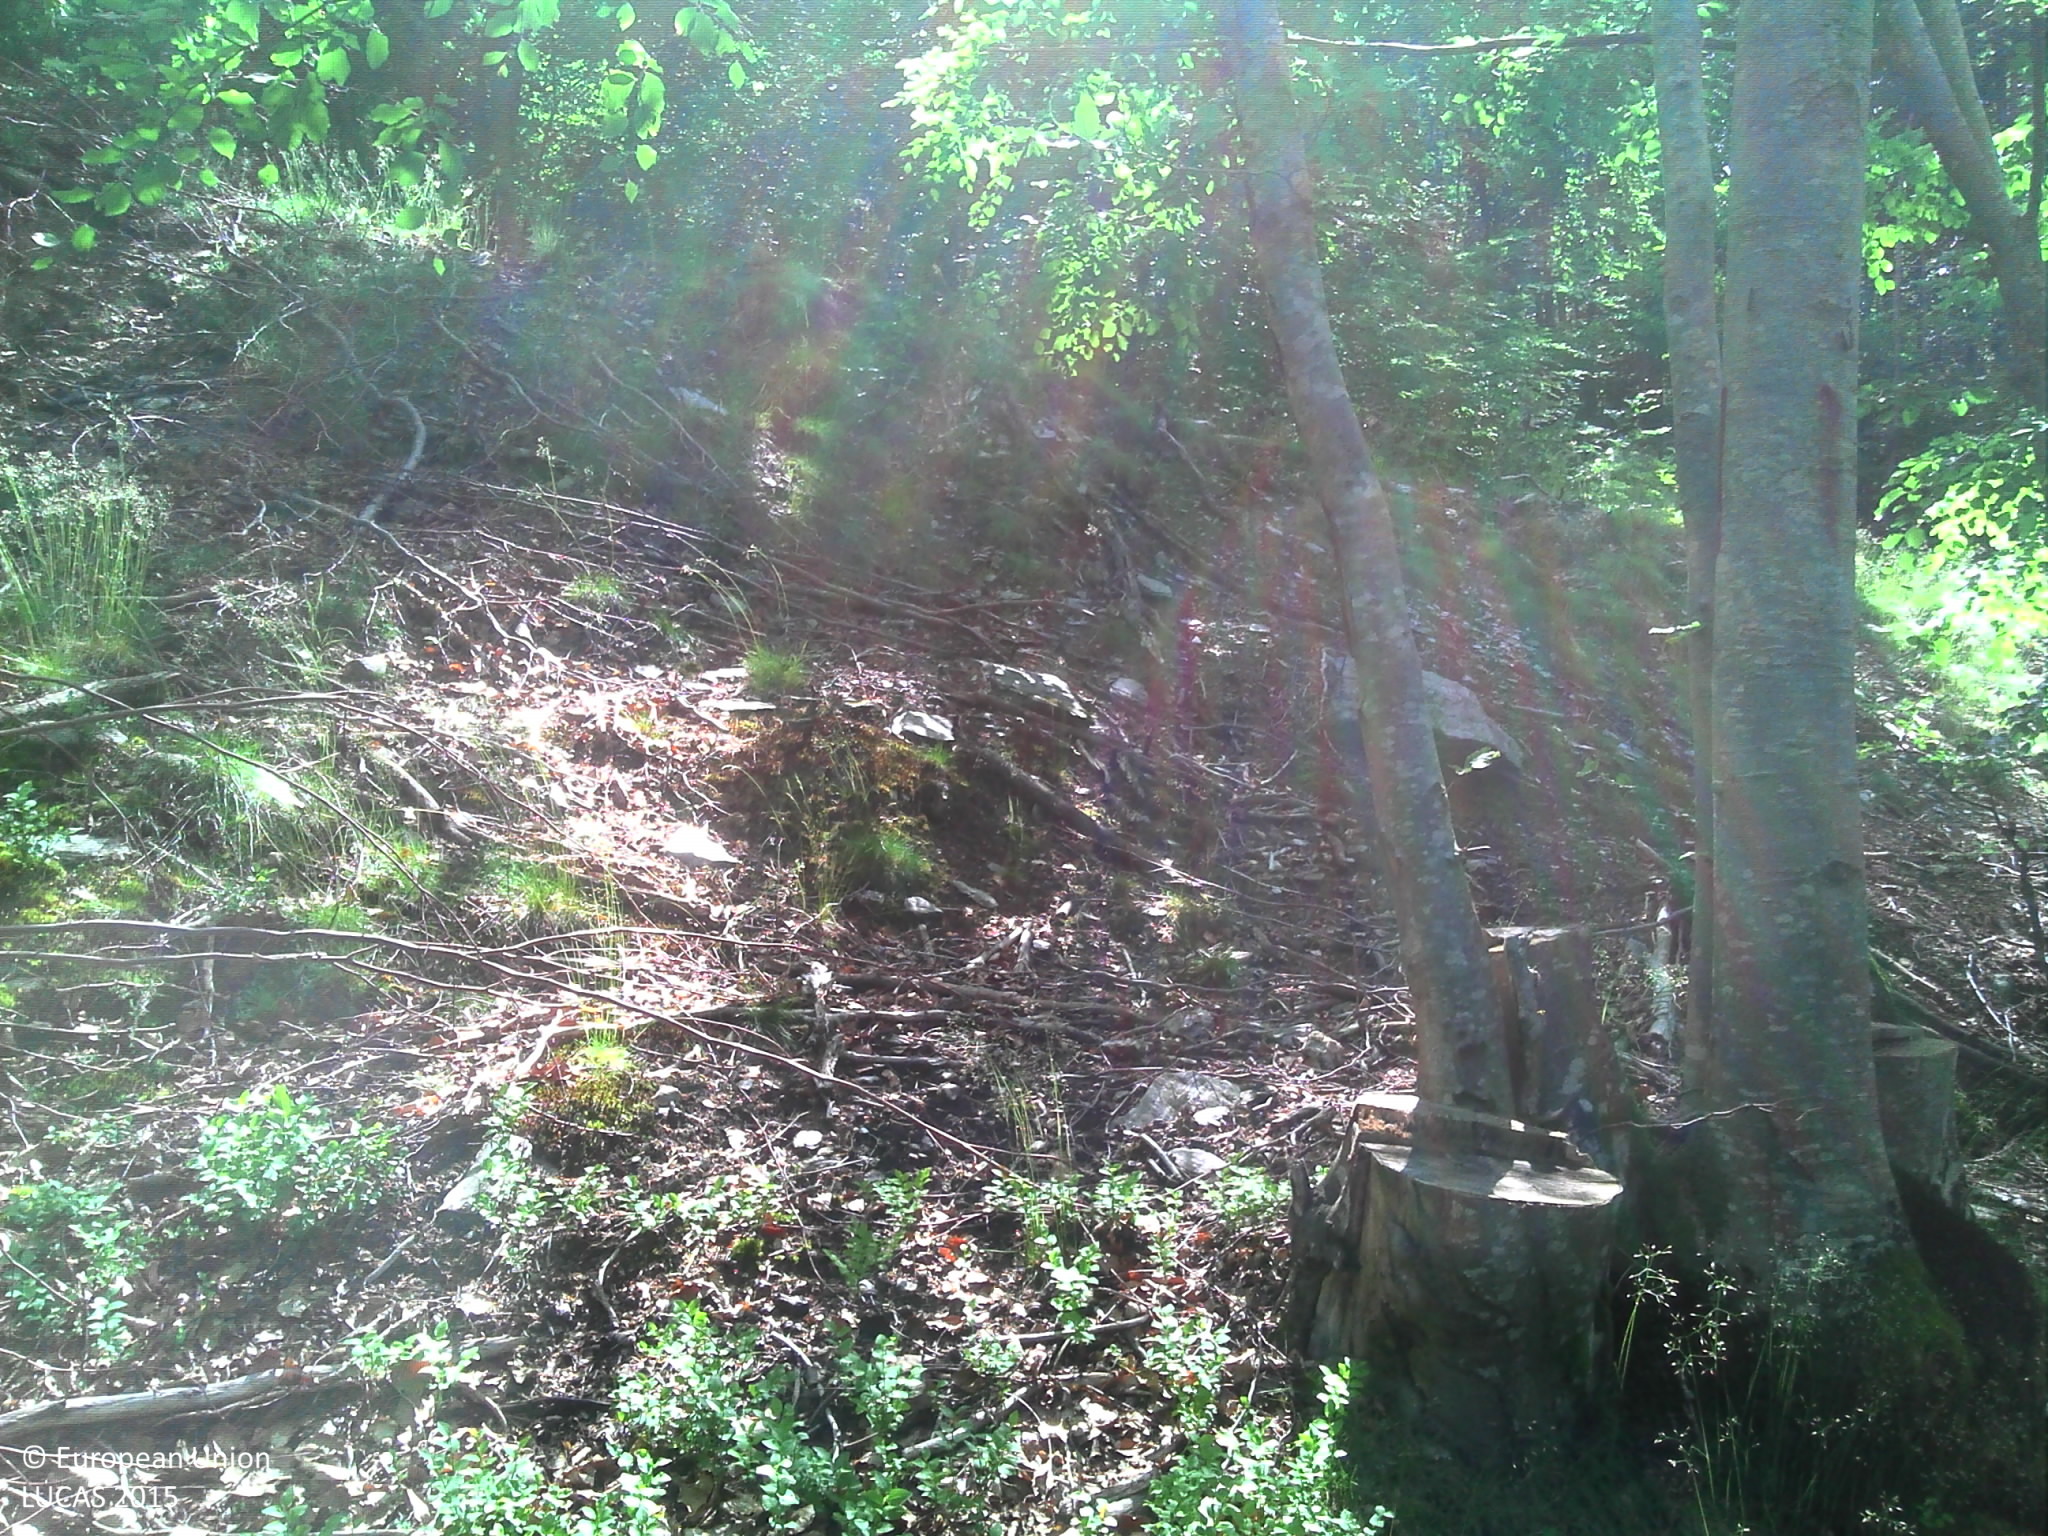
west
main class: Woodland
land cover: Other mixed woodland
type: mountainous beech forest
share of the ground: > 75 %
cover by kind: broadleaved forest trees 65 %, coniferous forest trees 25 %, herbaceous plants 10 %
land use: Forestry
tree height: > 5 m
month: June
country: FR
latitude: 44.5703
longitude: 3.9238
